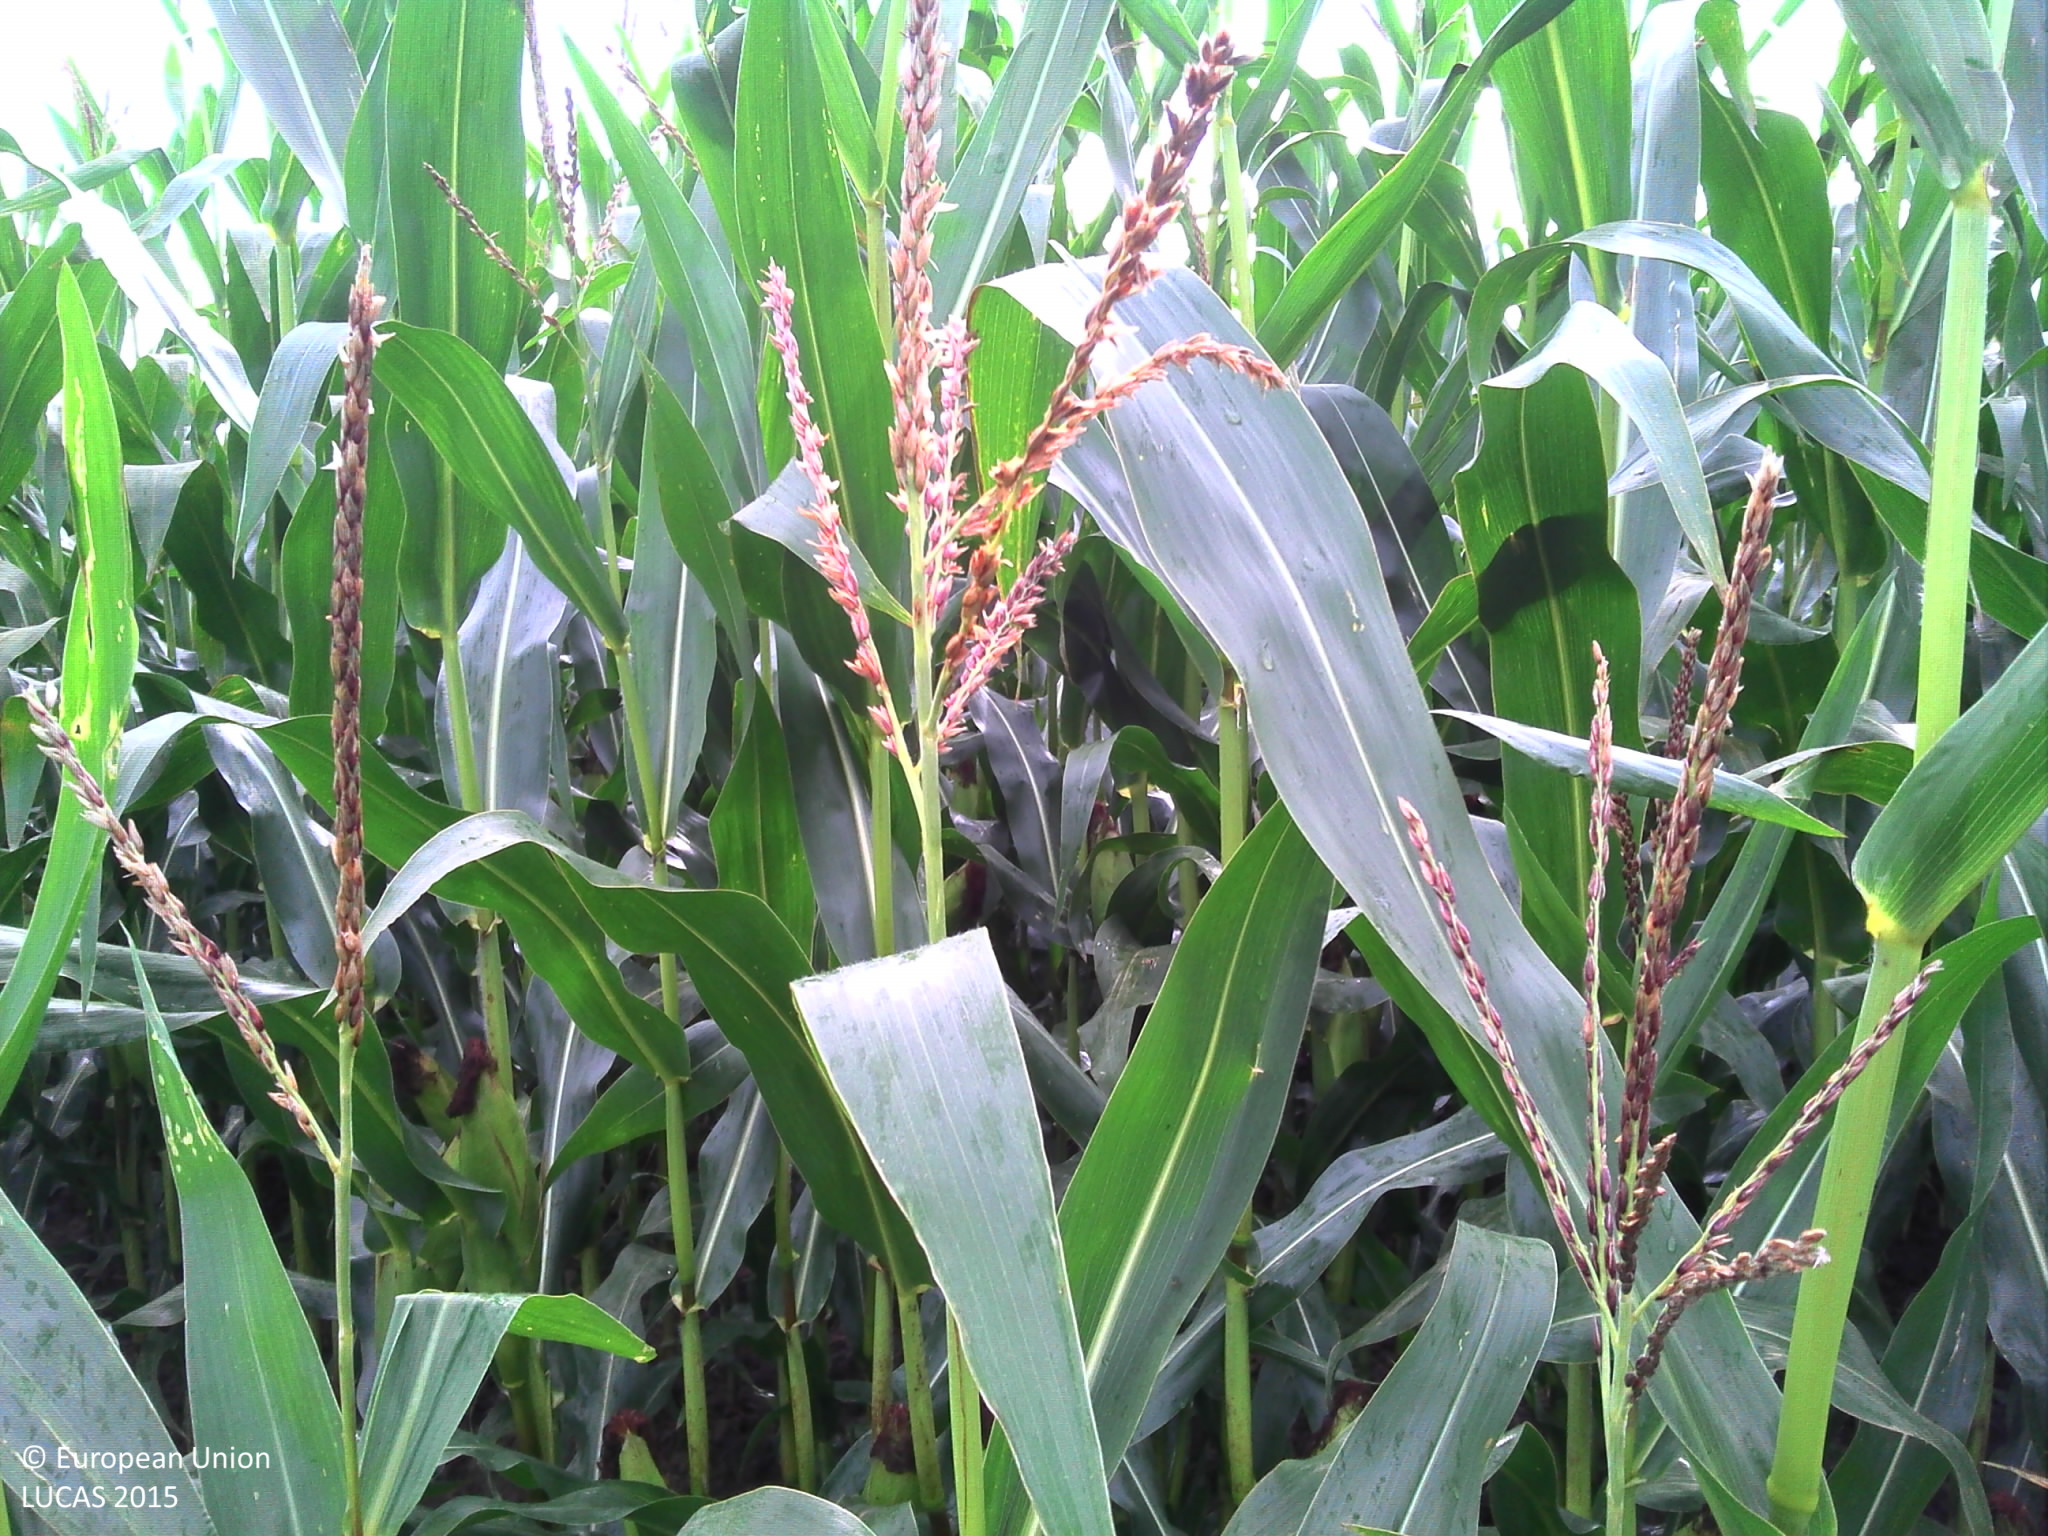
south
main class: Cropland
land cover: Maize
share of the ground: > 75 %
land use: Agriculture (excluding fallow land and kitchen gardens)
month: September
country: BE
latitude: 51.3198
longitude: 4.6441
